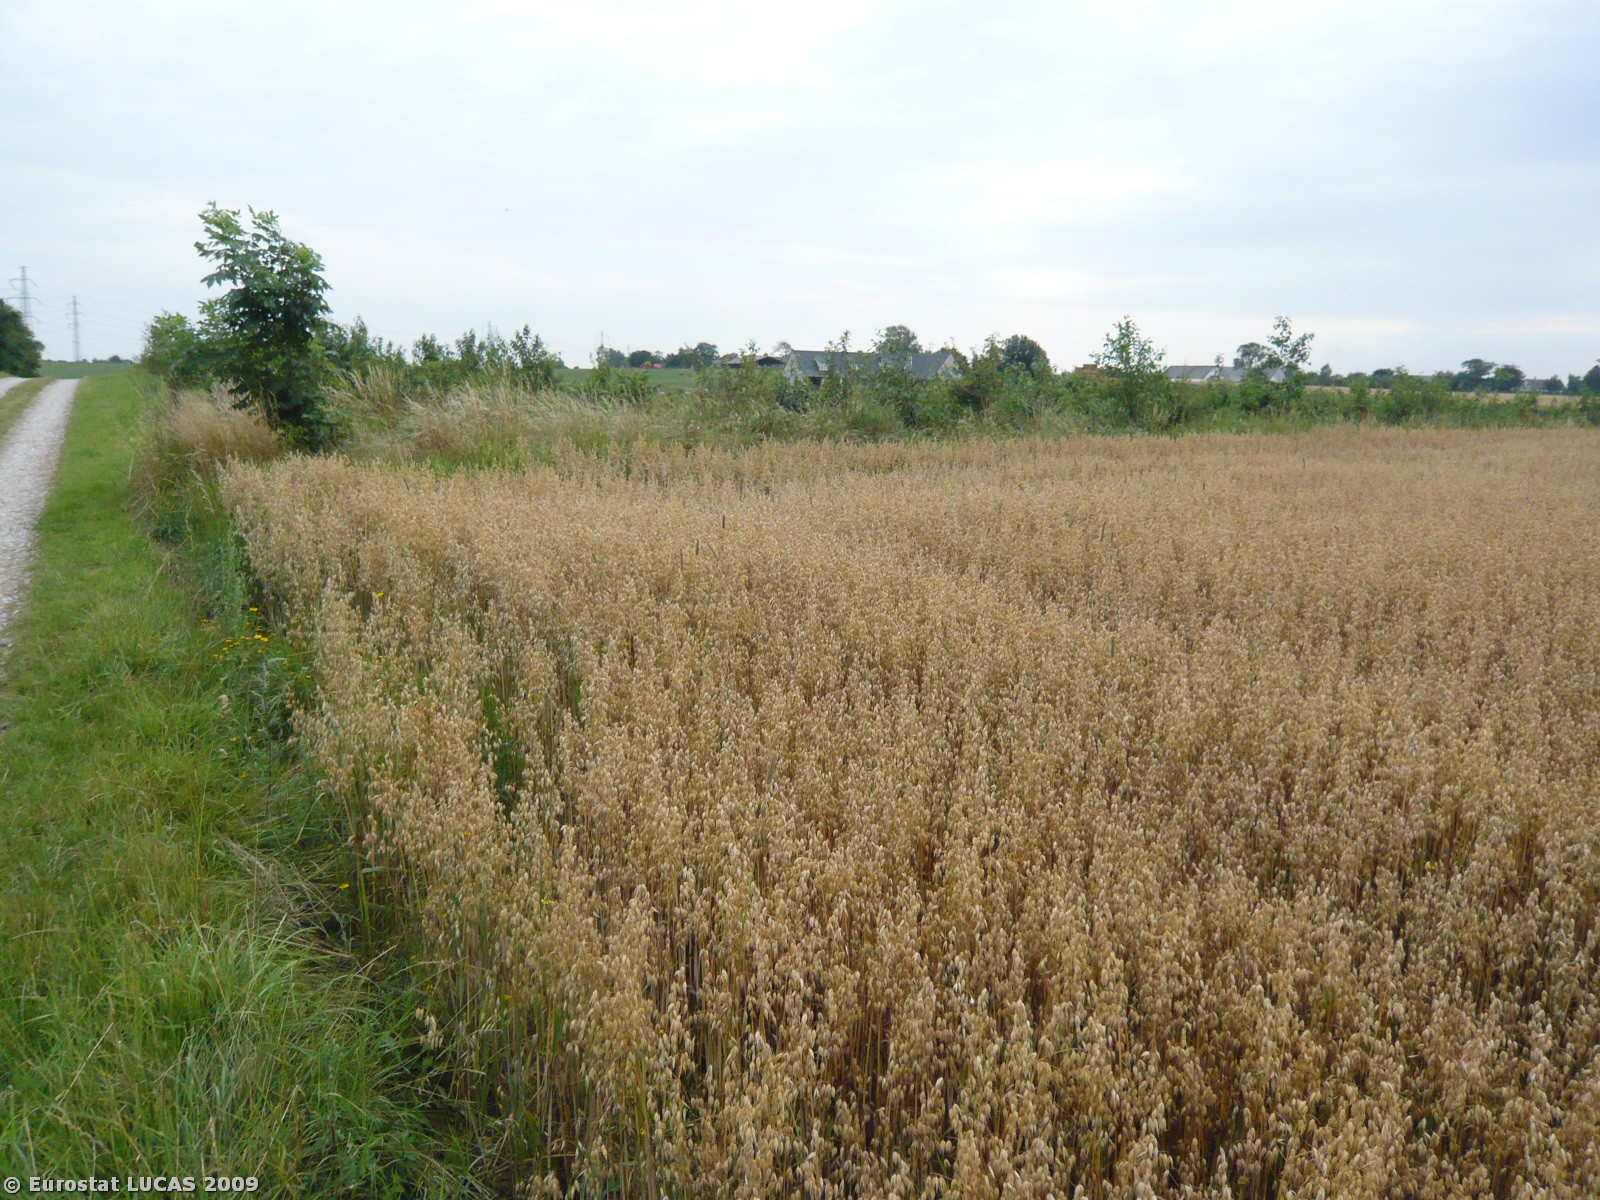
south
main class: Cropland
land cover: Oats
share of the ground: > 75 %
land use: Agriculture (excluding fallow land and kitchen gardens)
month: July
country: DK
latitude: 55.8640
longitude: 12.1551
